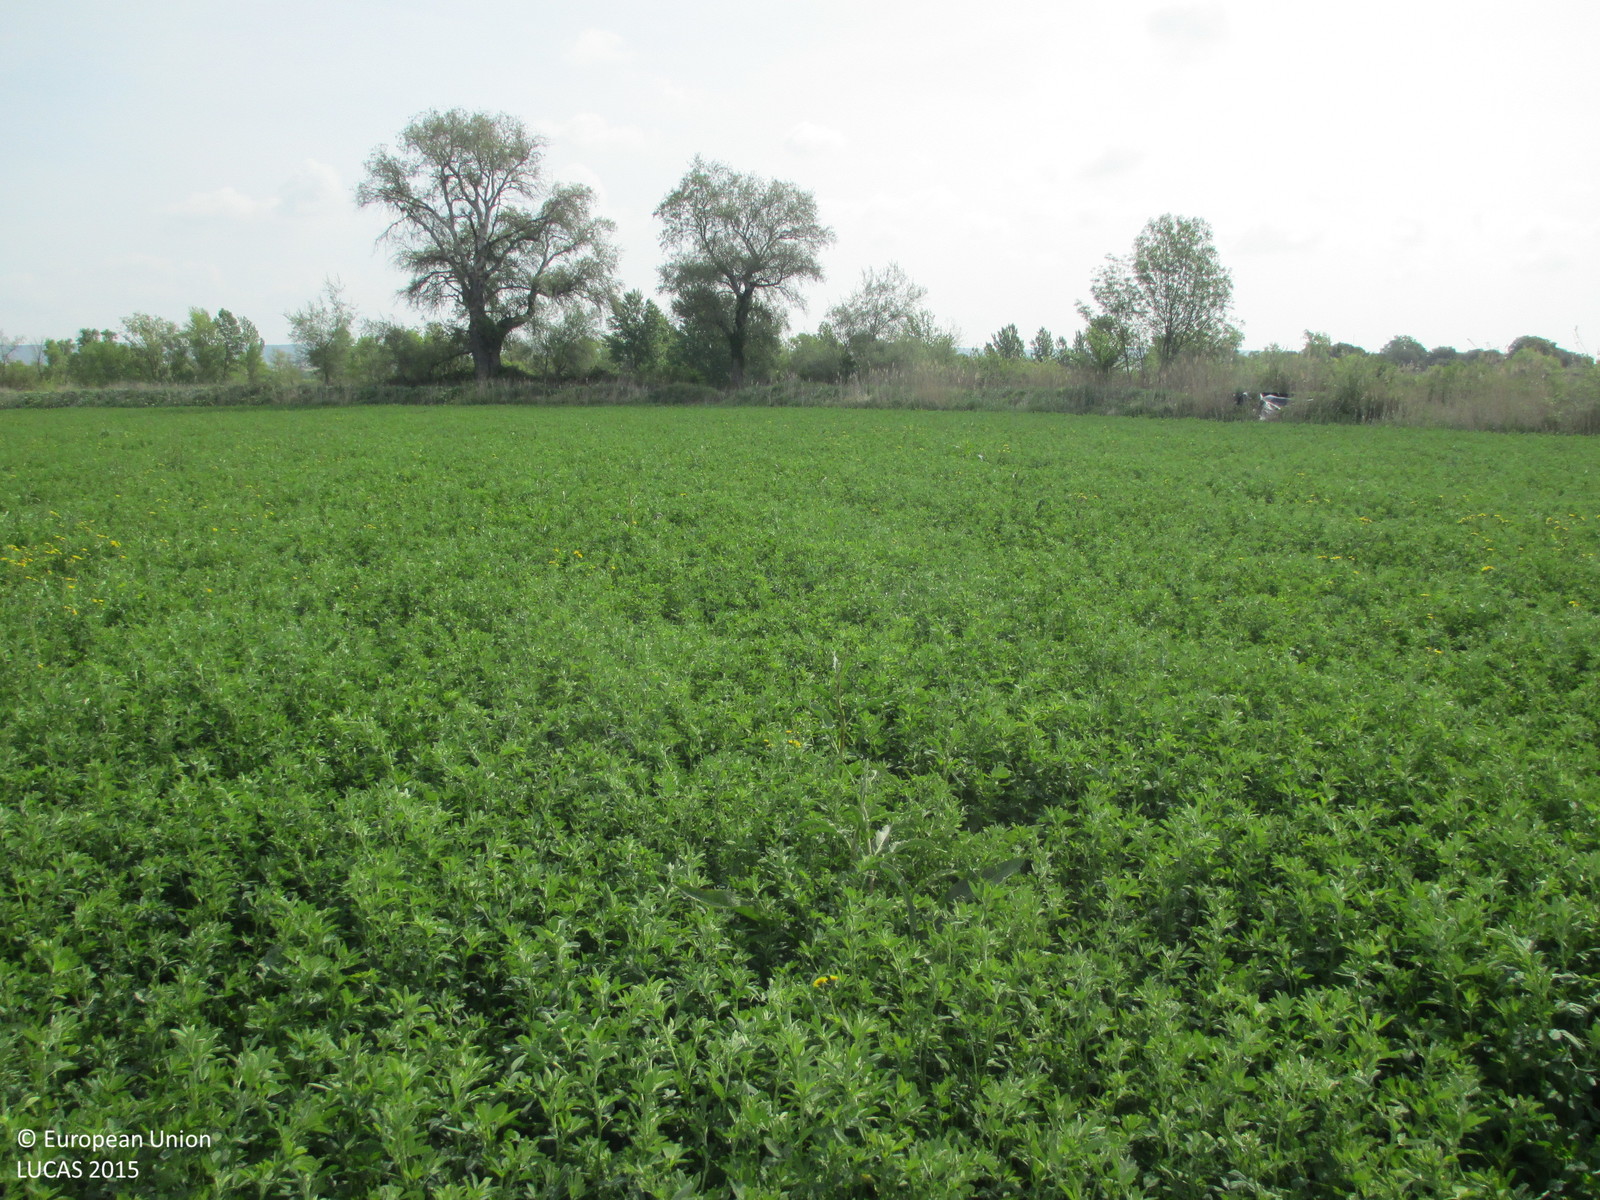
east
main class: Cropland
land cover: Lucerne
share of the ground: > 75 %
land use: Agriculture (excluding fallow land and kitchen gardens)
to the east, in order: Lucerne; Abandoned hedges; Ditches and canals; Abandoned hedges; Lucerne; Shruby margins; Abandoned hedges; Lucerne; Grass margins; Lucerne; Grass margins; Abandoned hedges; Grass margins; Durum wheat; Grass margins; Abandoned hedges; Inland fresh running water; Grassland without tree/shrub cover; Barley
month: April
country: ES
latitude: 42.0827
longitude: -0.3817
